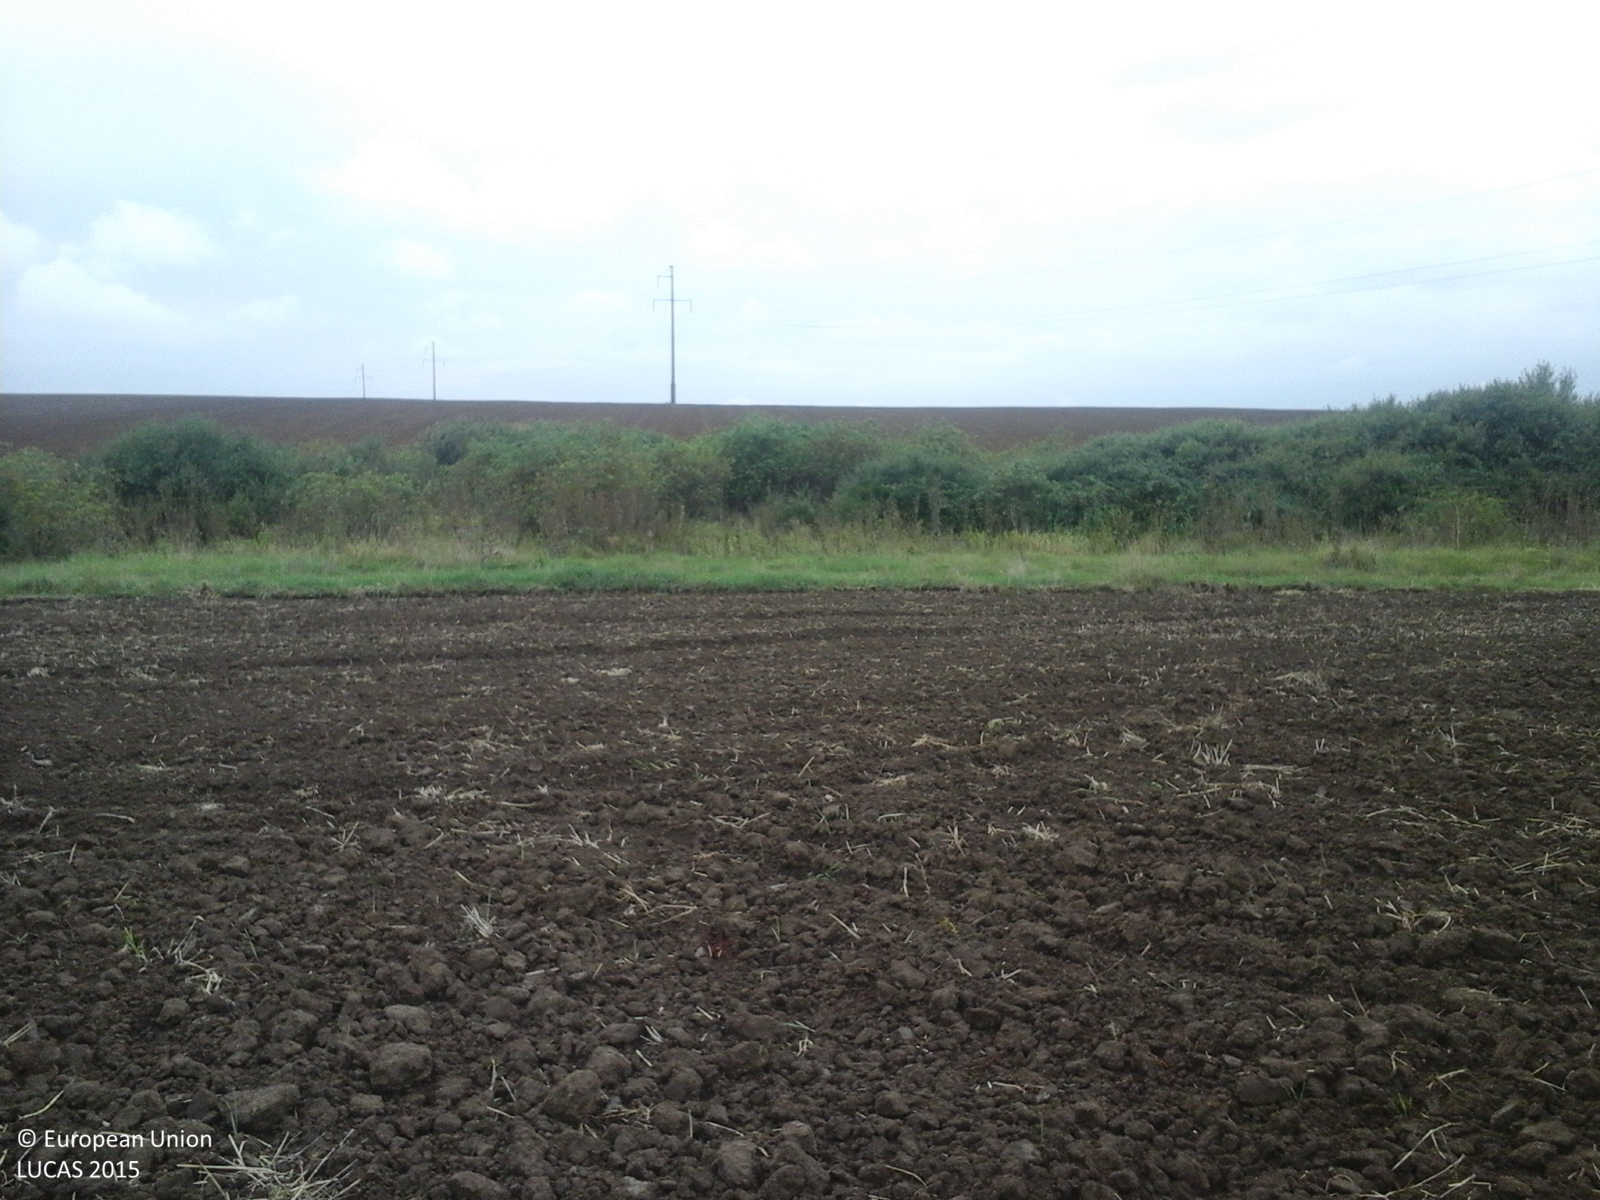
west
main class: Cropland
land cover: Common wheat
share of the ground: < 10 %
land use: Agriculture (excluding fallow land and kitchen gardens)
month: September
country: RO
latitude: 47.1962
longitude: 22.0470
